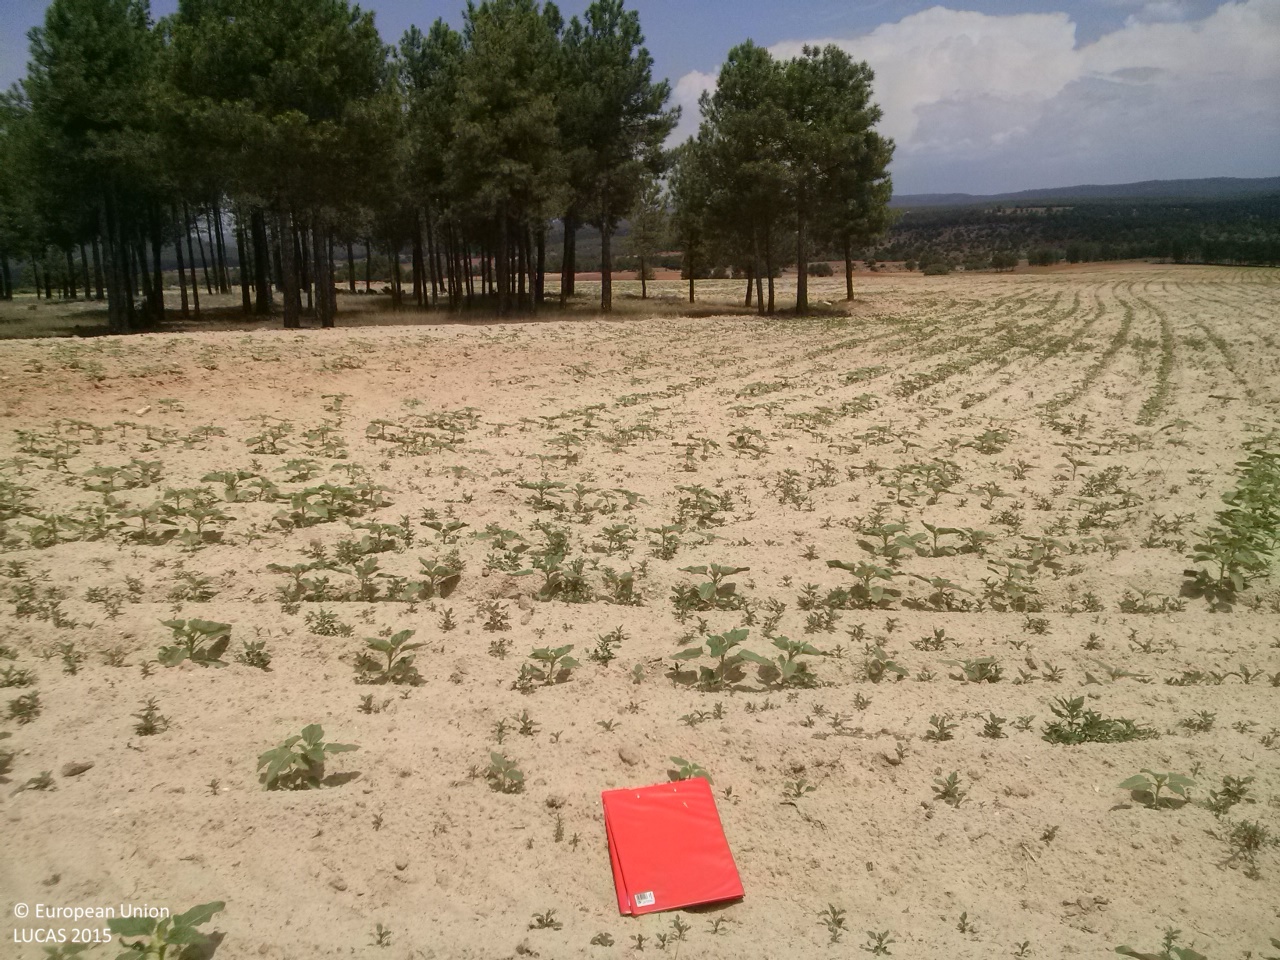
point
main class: Cropland
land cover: Sunflower
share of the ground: < 10 %
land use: Agriculture (excluding fallow land and kitchen gardens)
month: June
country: ES
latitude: 39.9573
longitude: -1.7759
